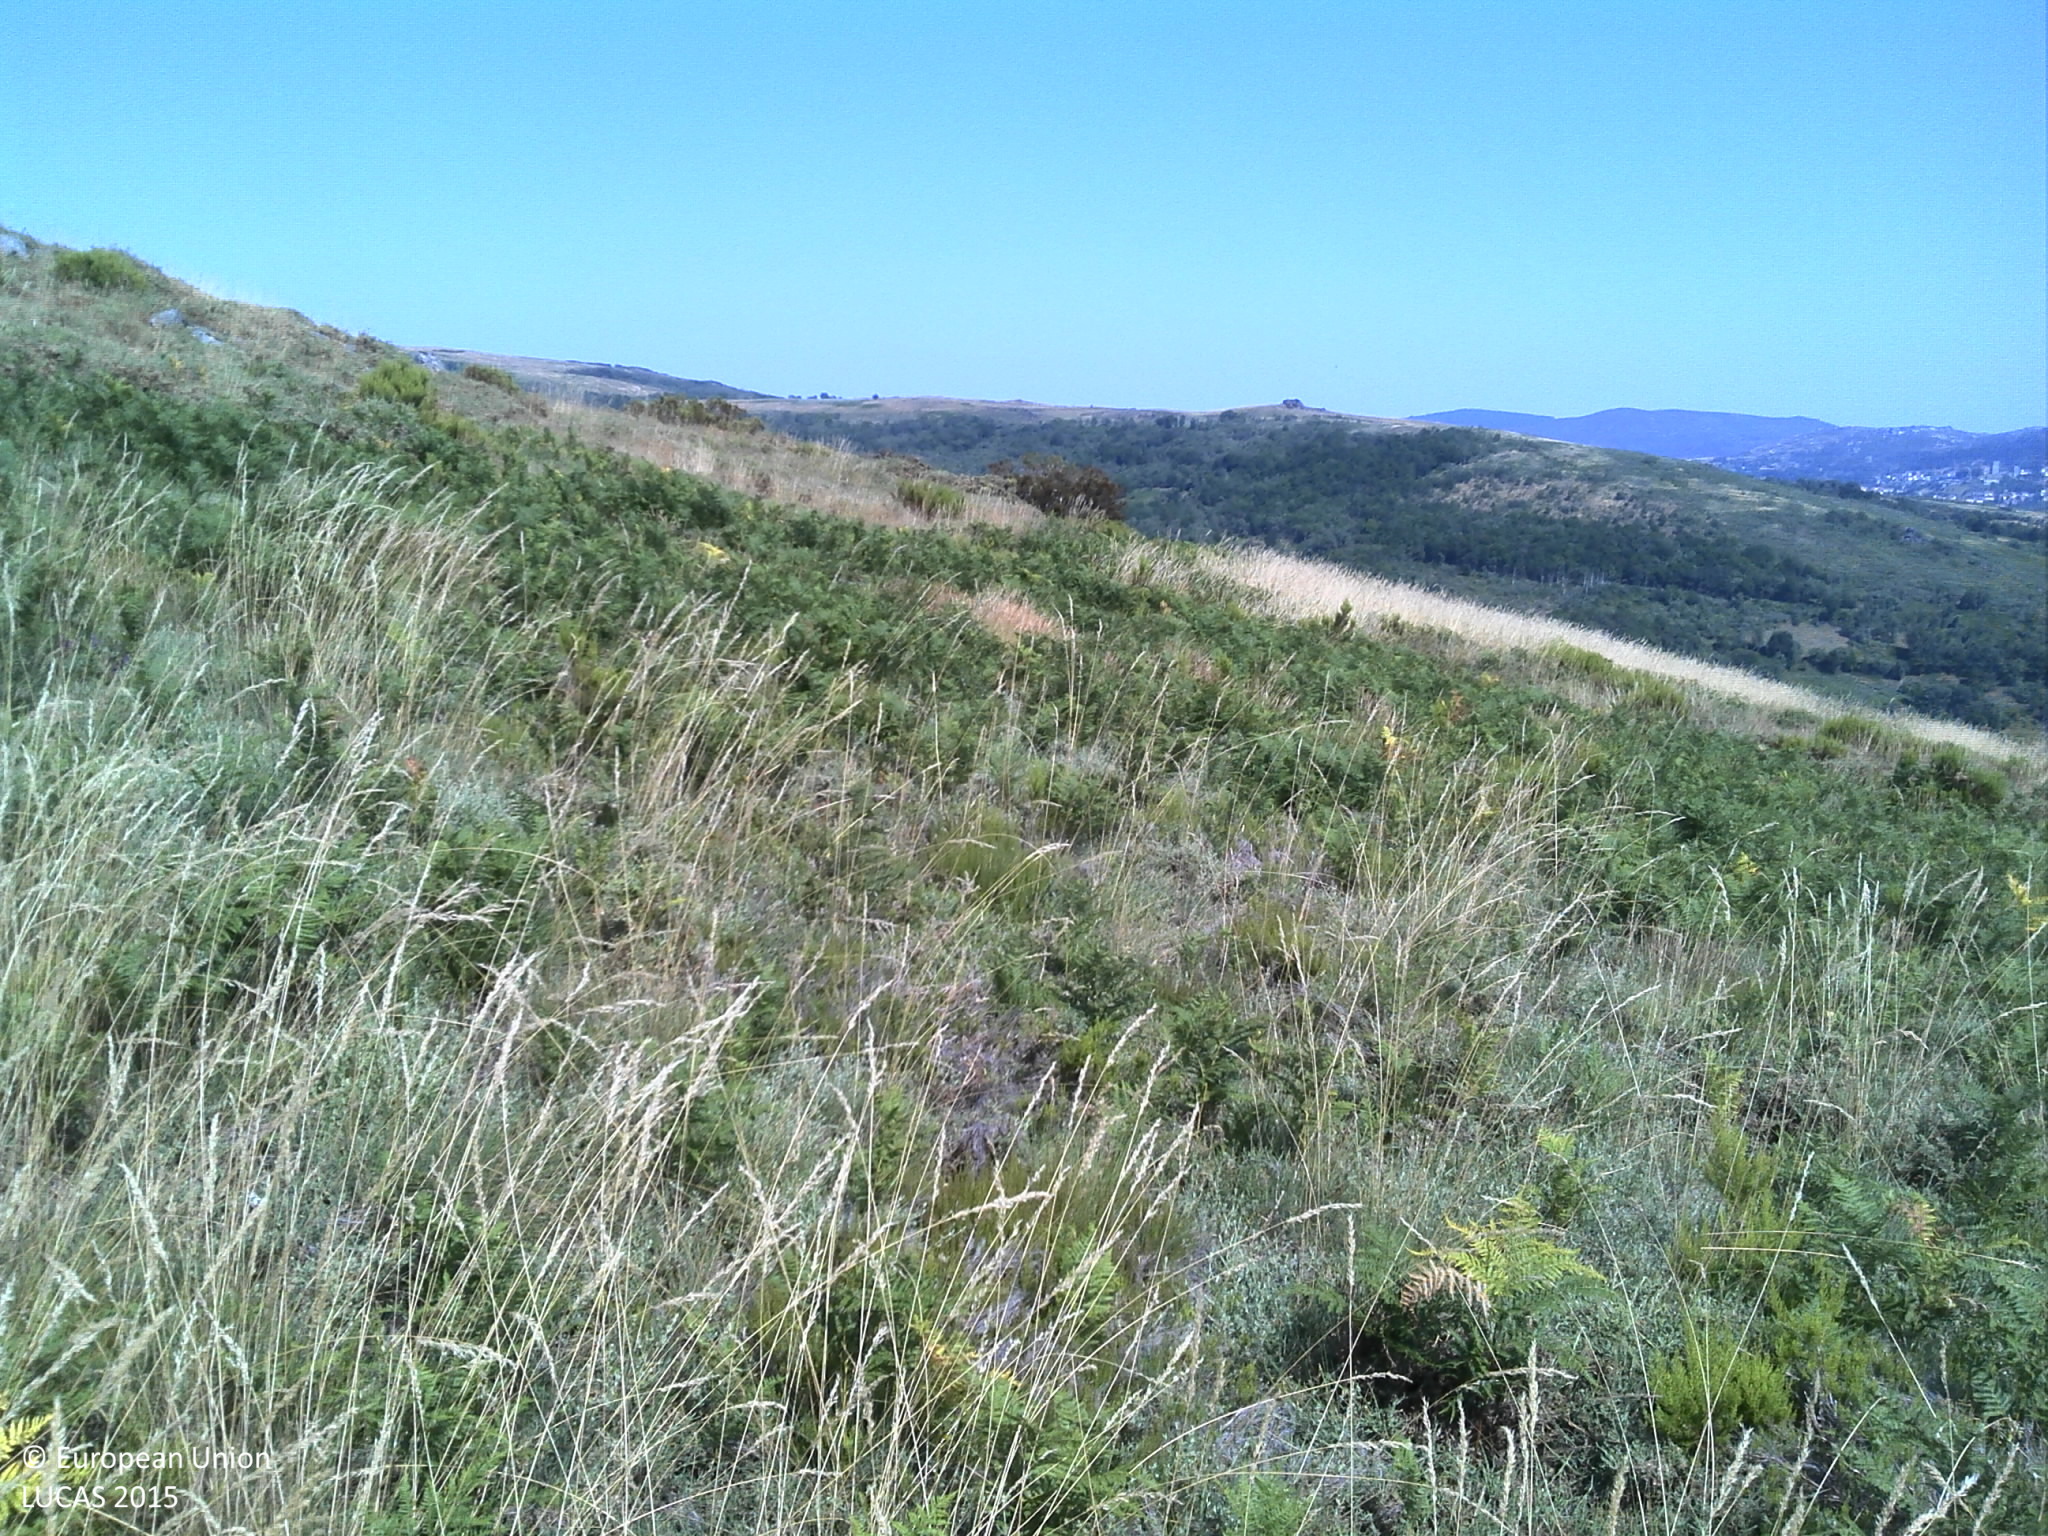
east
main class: Shrubland
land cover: Shrubland without tree cover
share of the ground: 50 - 75 %
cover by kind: shrubs 50 %, herbaceous plants 50 %
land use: Agriculture (excluding fallow land and kitchen gardens)
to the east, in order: Shrubland without tree cover; Rock outcrops; Shrubland without tree cover; Rock outcrops; Shrubland without tree cover; Other bare soil; Shrubland without tree cover; Dry stone walls; Shrubland without tree cover; Rock outcrops; Shrubland without tree cover
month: July
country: PT
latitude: 41.8493
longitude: -7.8350
